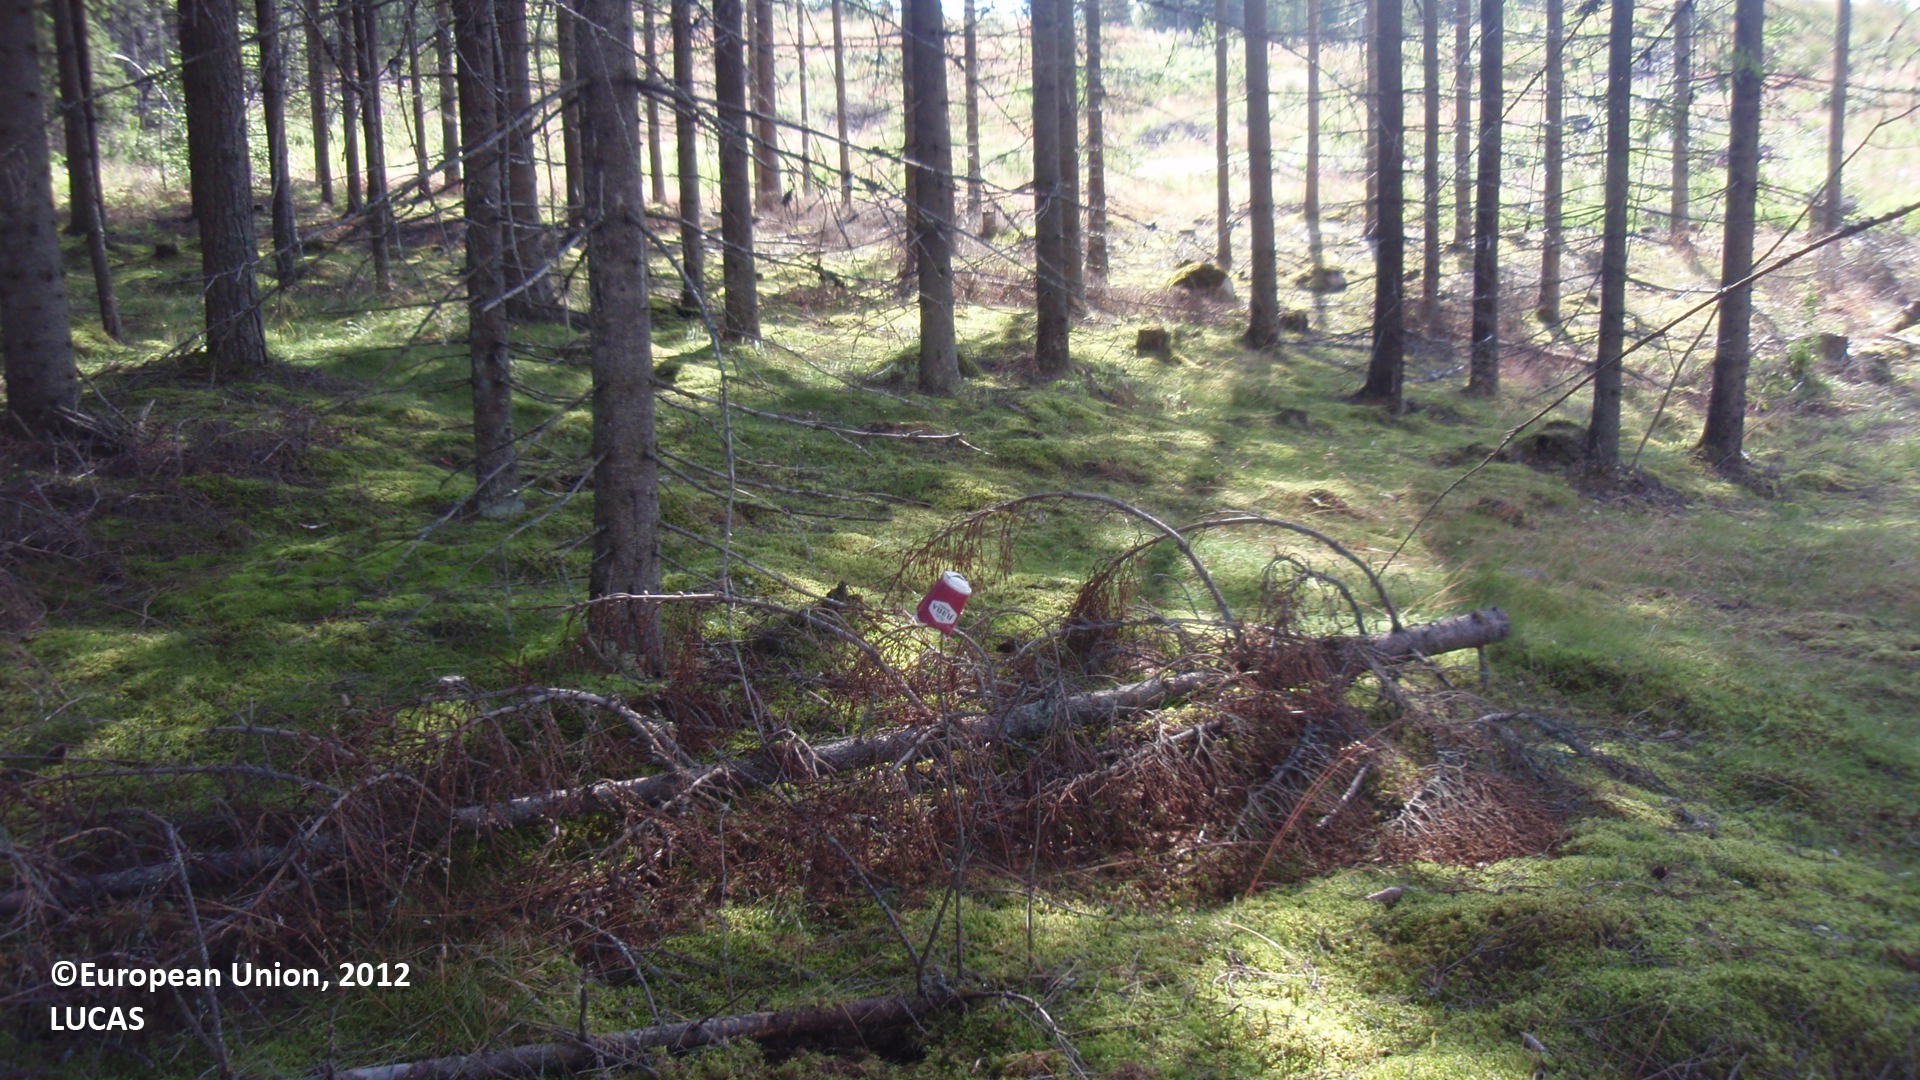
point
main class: Woodland
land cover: Spruce dominated coniferous woodland
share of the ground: 50 - 75 %
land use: Forestry
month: July
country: FI
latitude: 61.4294
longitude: 29.0722
